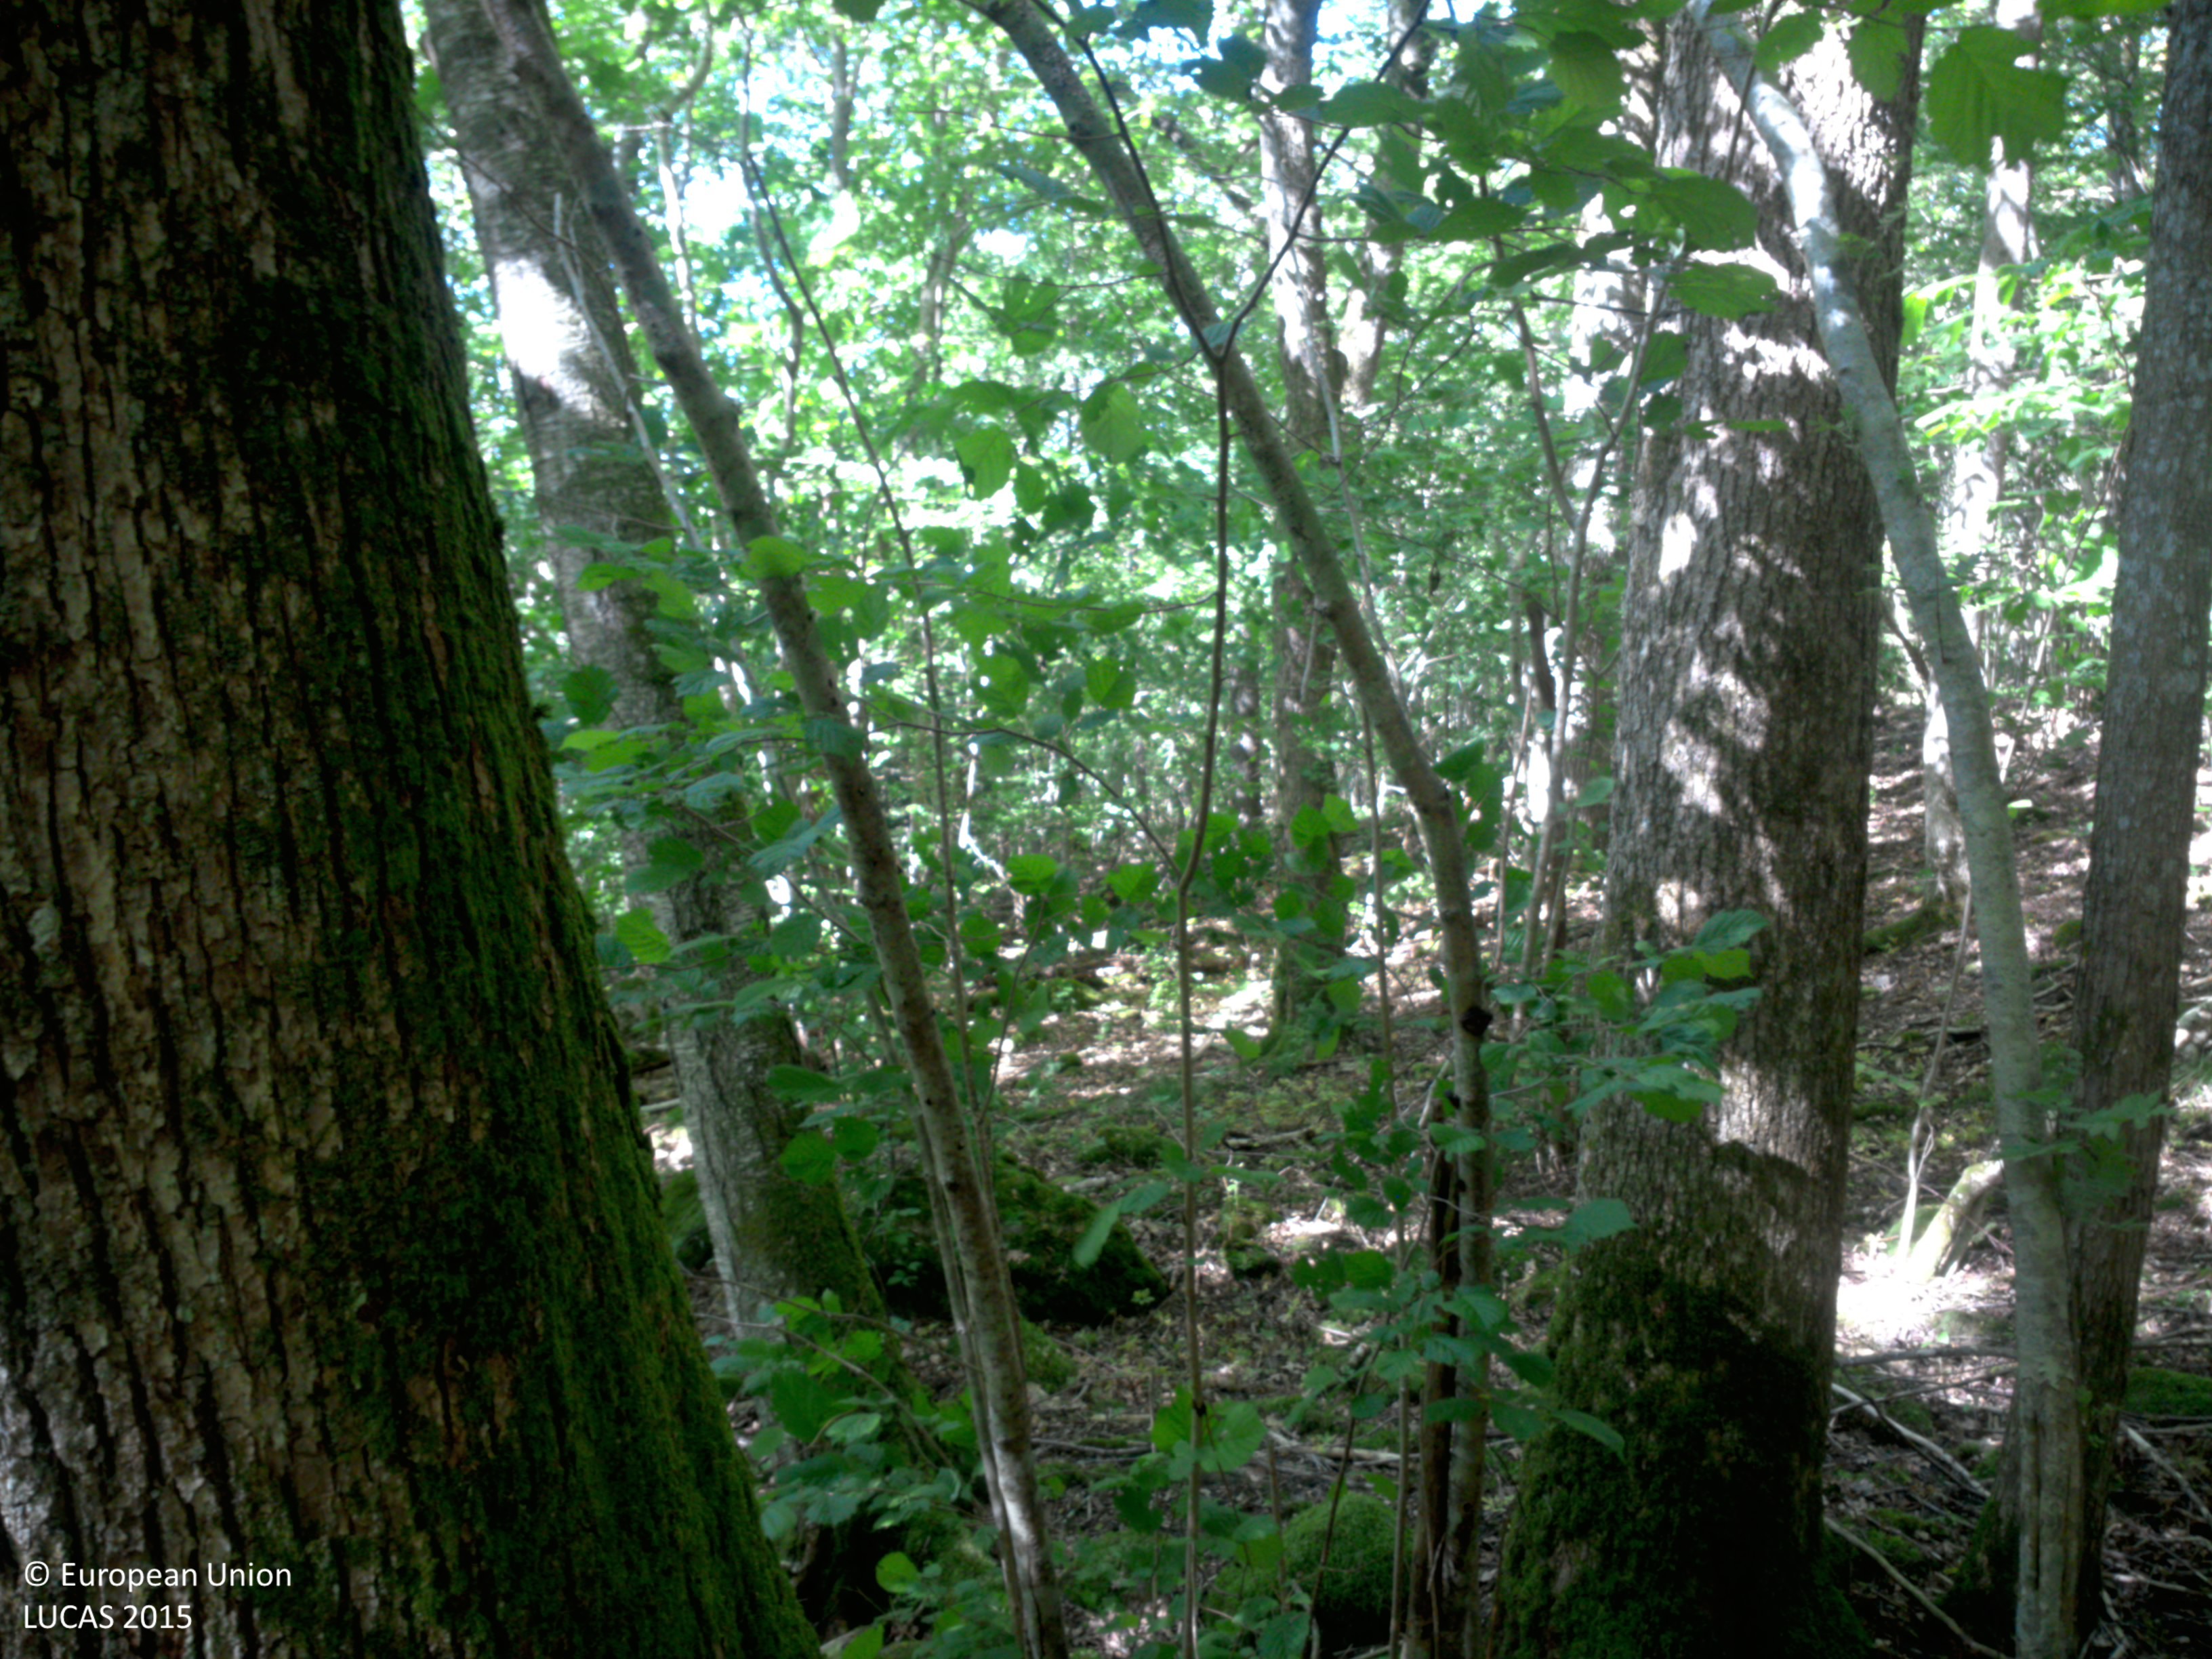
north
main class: Woodland
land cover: Broadleaved woodland
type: hemiboreal forest and nemoral coniferous forest and mixed broadleaved-coniferous forest
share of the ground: > 75 %
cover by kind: broadleaved forest trees 85 %, lichens and mosses 15 %
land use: Amenities, museums, leisure
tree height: > 5 m
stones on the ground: < 10 %
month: June
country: SE
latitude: 58.4607
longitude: 11.6933
